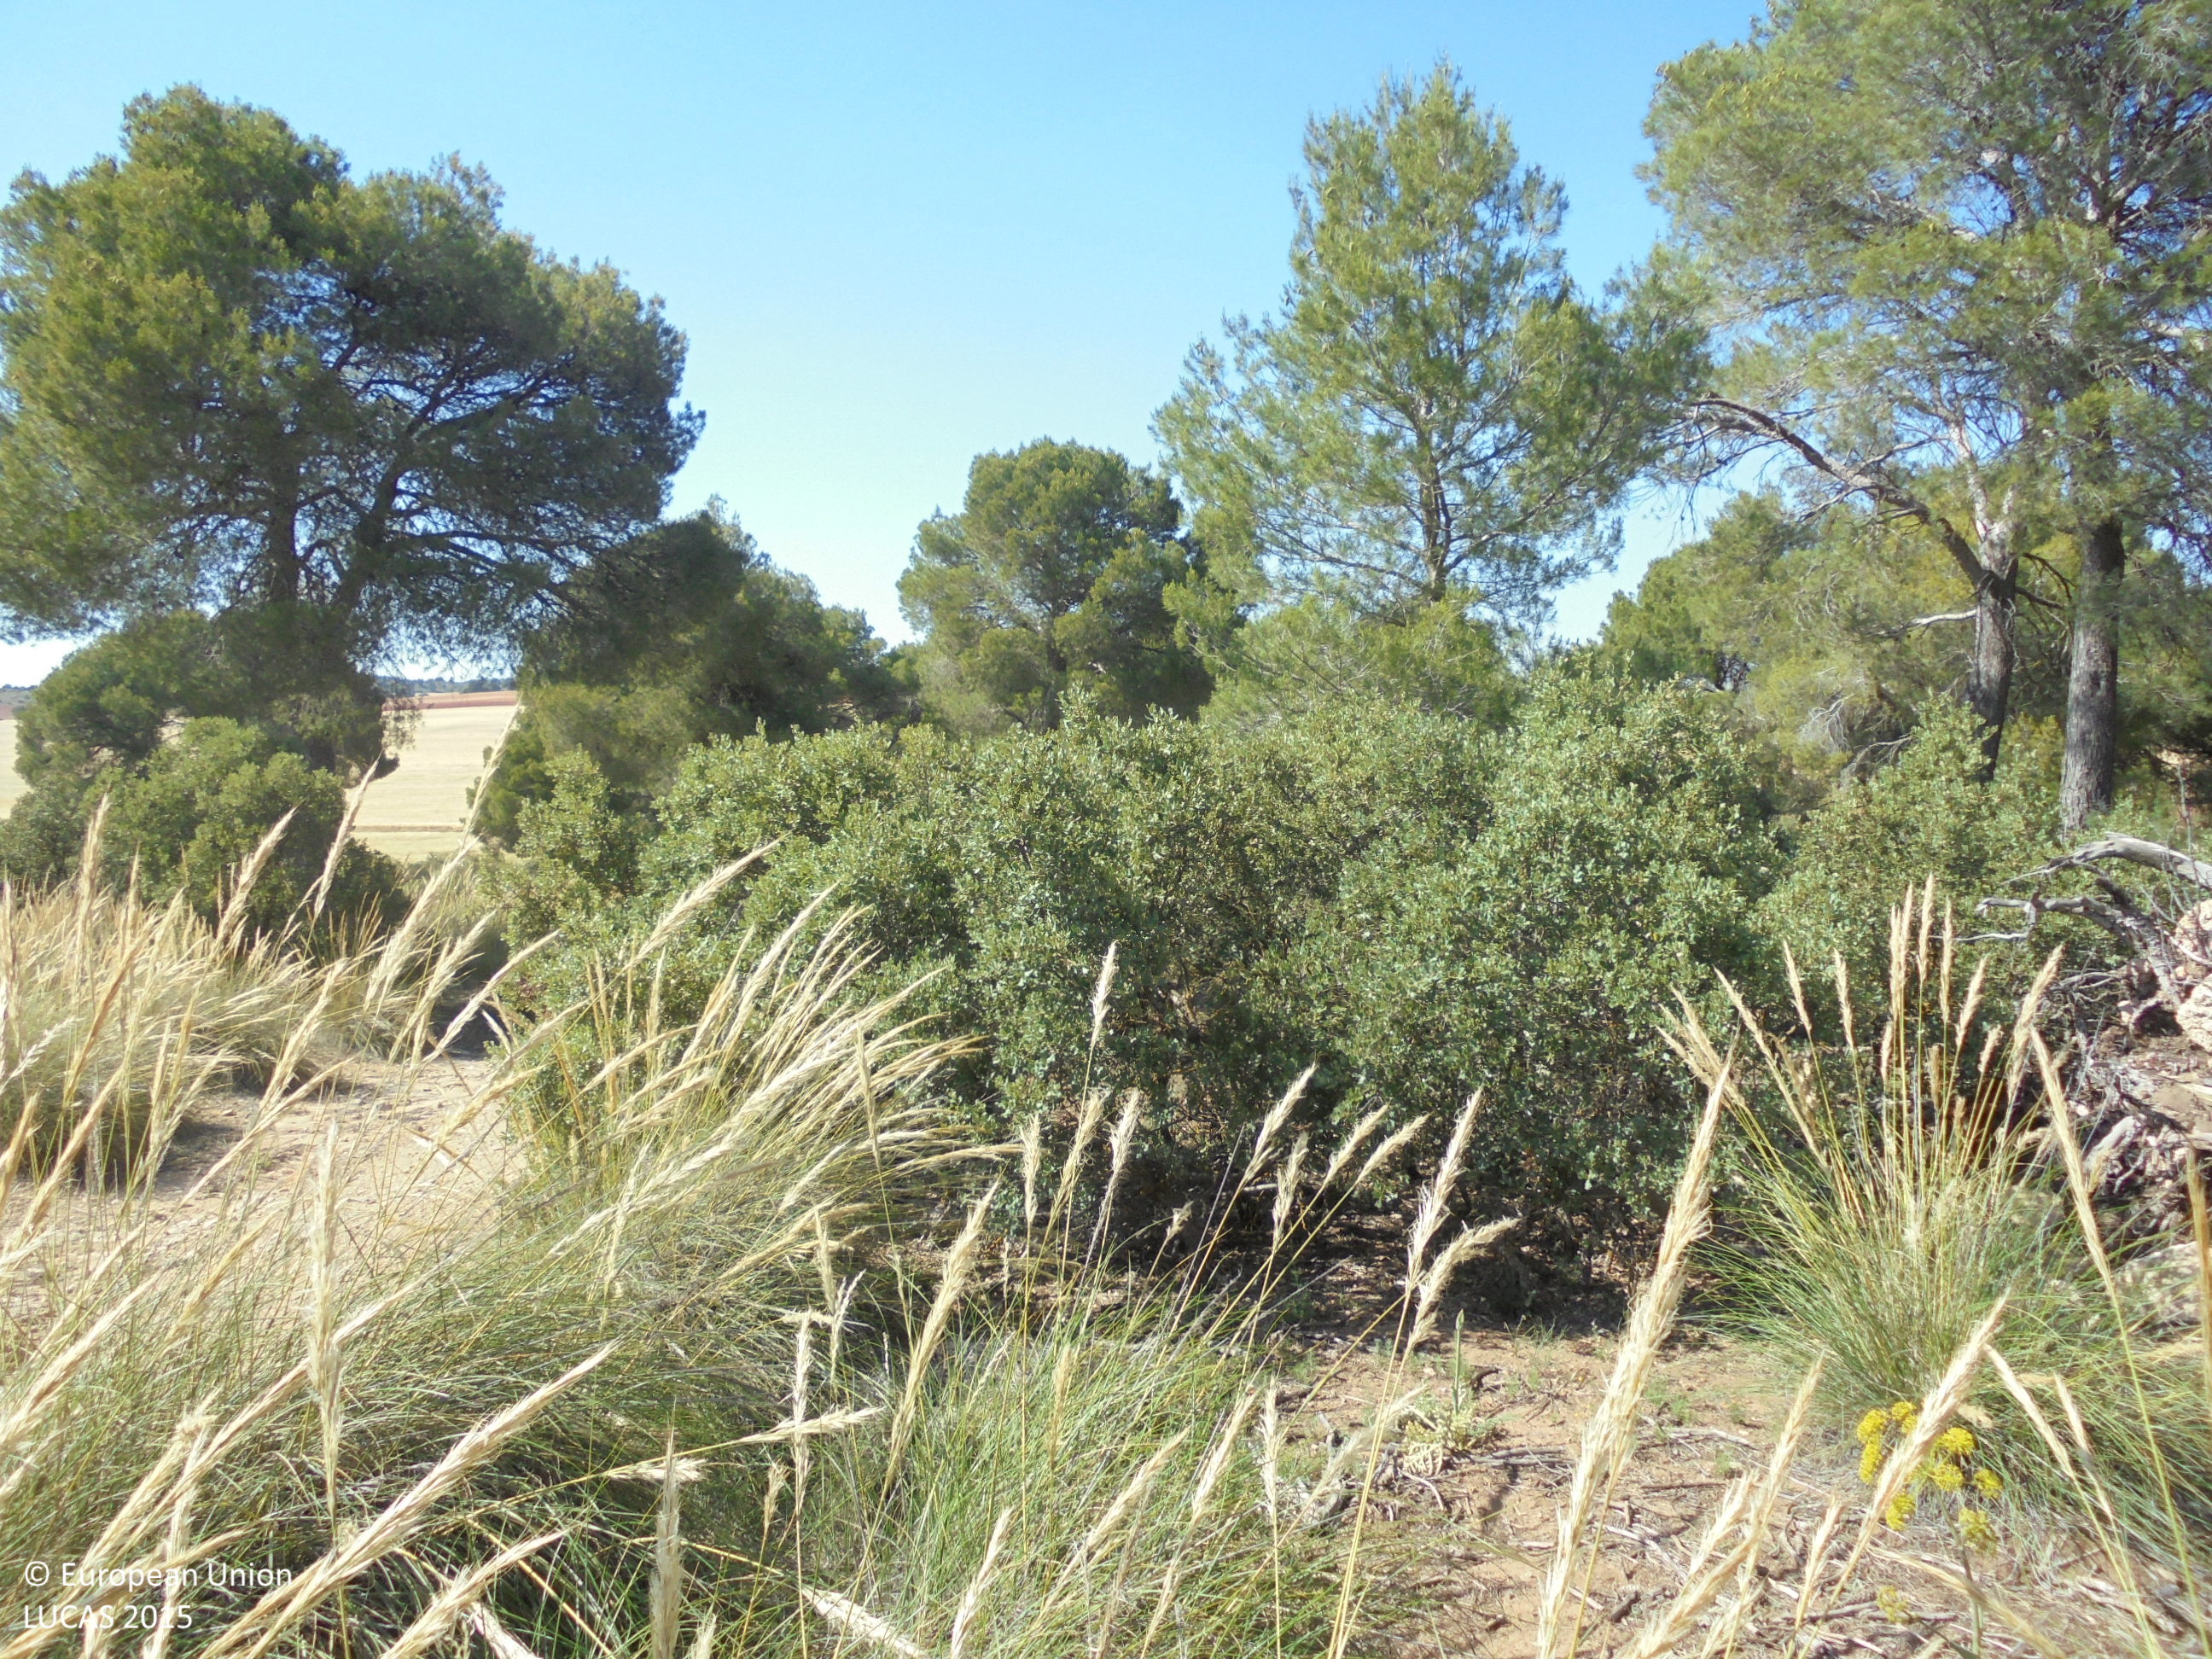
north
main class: Woodland
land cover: Pine dominated coniferous woodland
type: coniferous forest of the mediterranean region
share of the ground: 50 - 75 %
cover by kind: coniferous forest trees 60 %, shrubs 30 %, unconsolidated bare surface 10 %
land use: Semi-natural and natural areas not in use
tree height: > 5 m
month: June
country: ES
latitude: 38.7635
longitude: -1.6774
